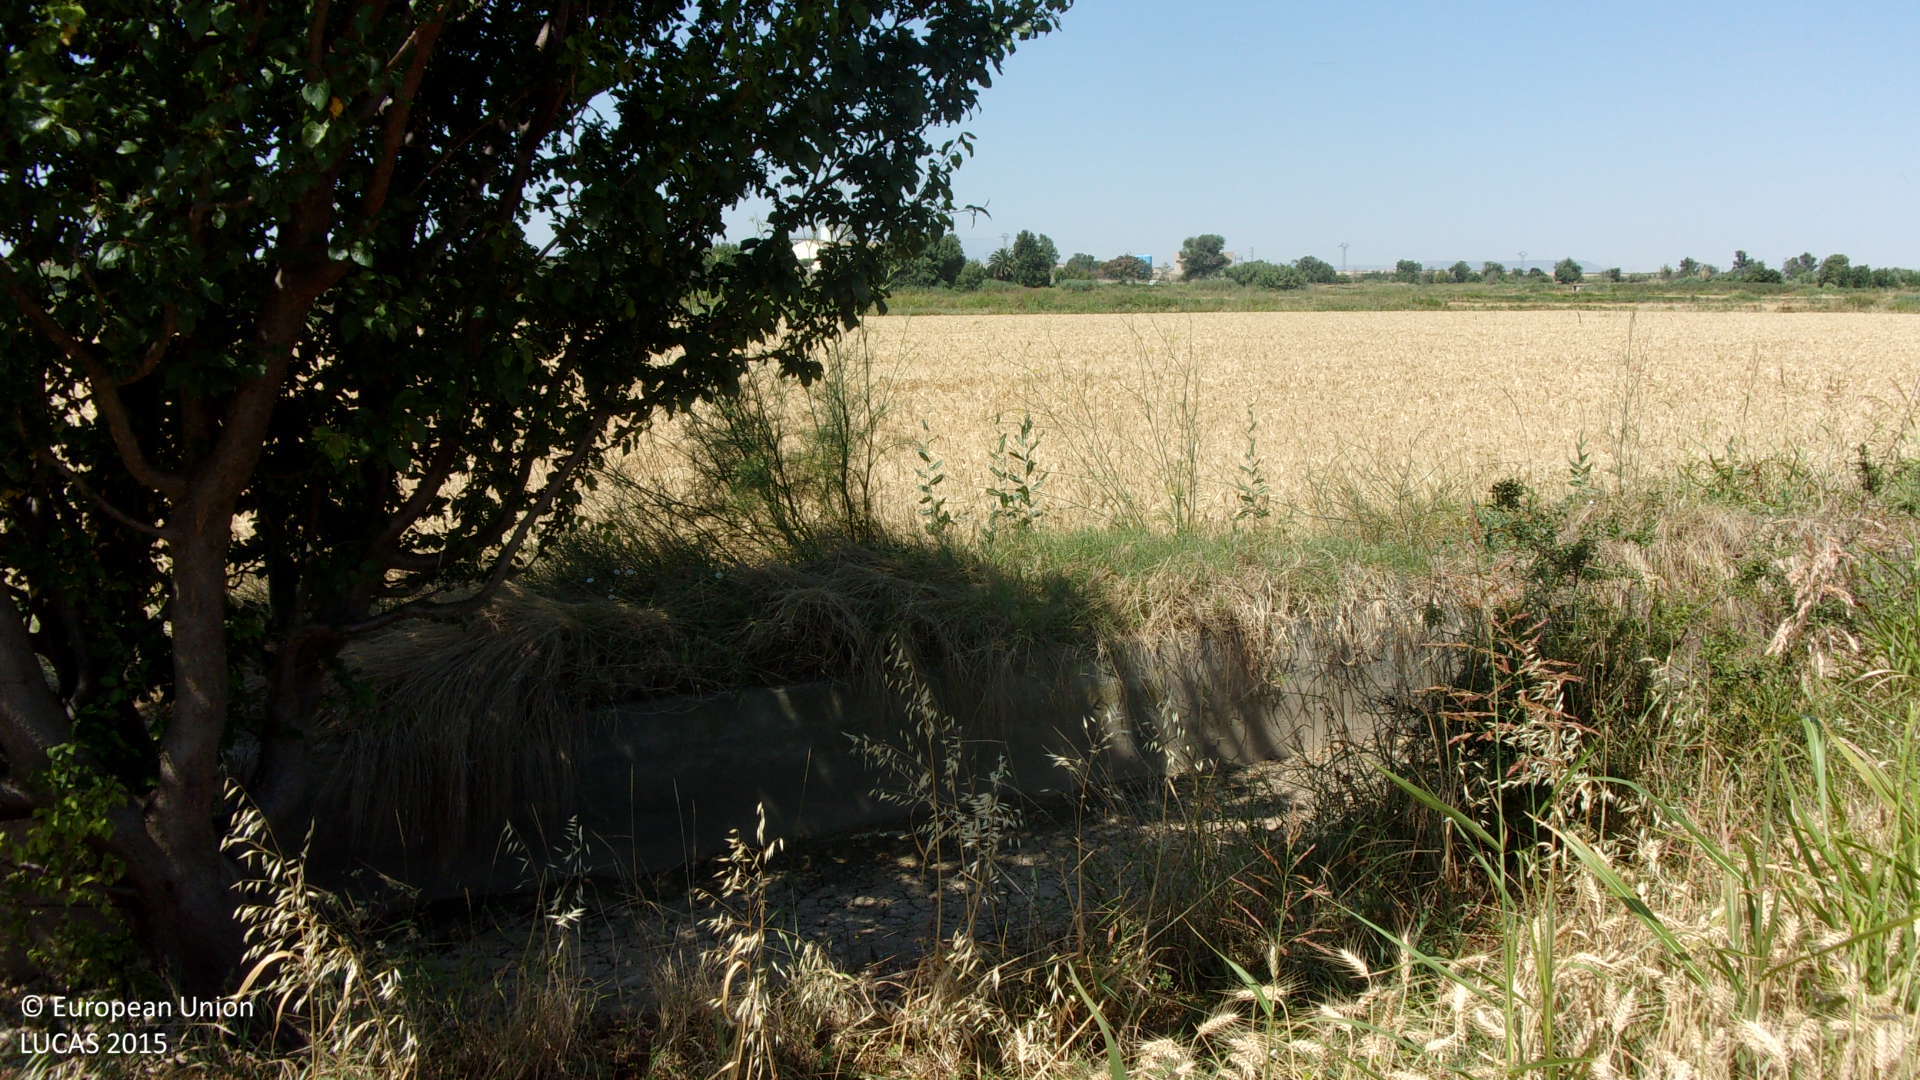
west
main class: Cropland
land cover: Common wheat
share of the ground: > 75 %
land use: Agriculture (excluding fallow land and kitchen gardens)
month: July
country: ES
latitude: 41.8389
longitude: -1.2865
